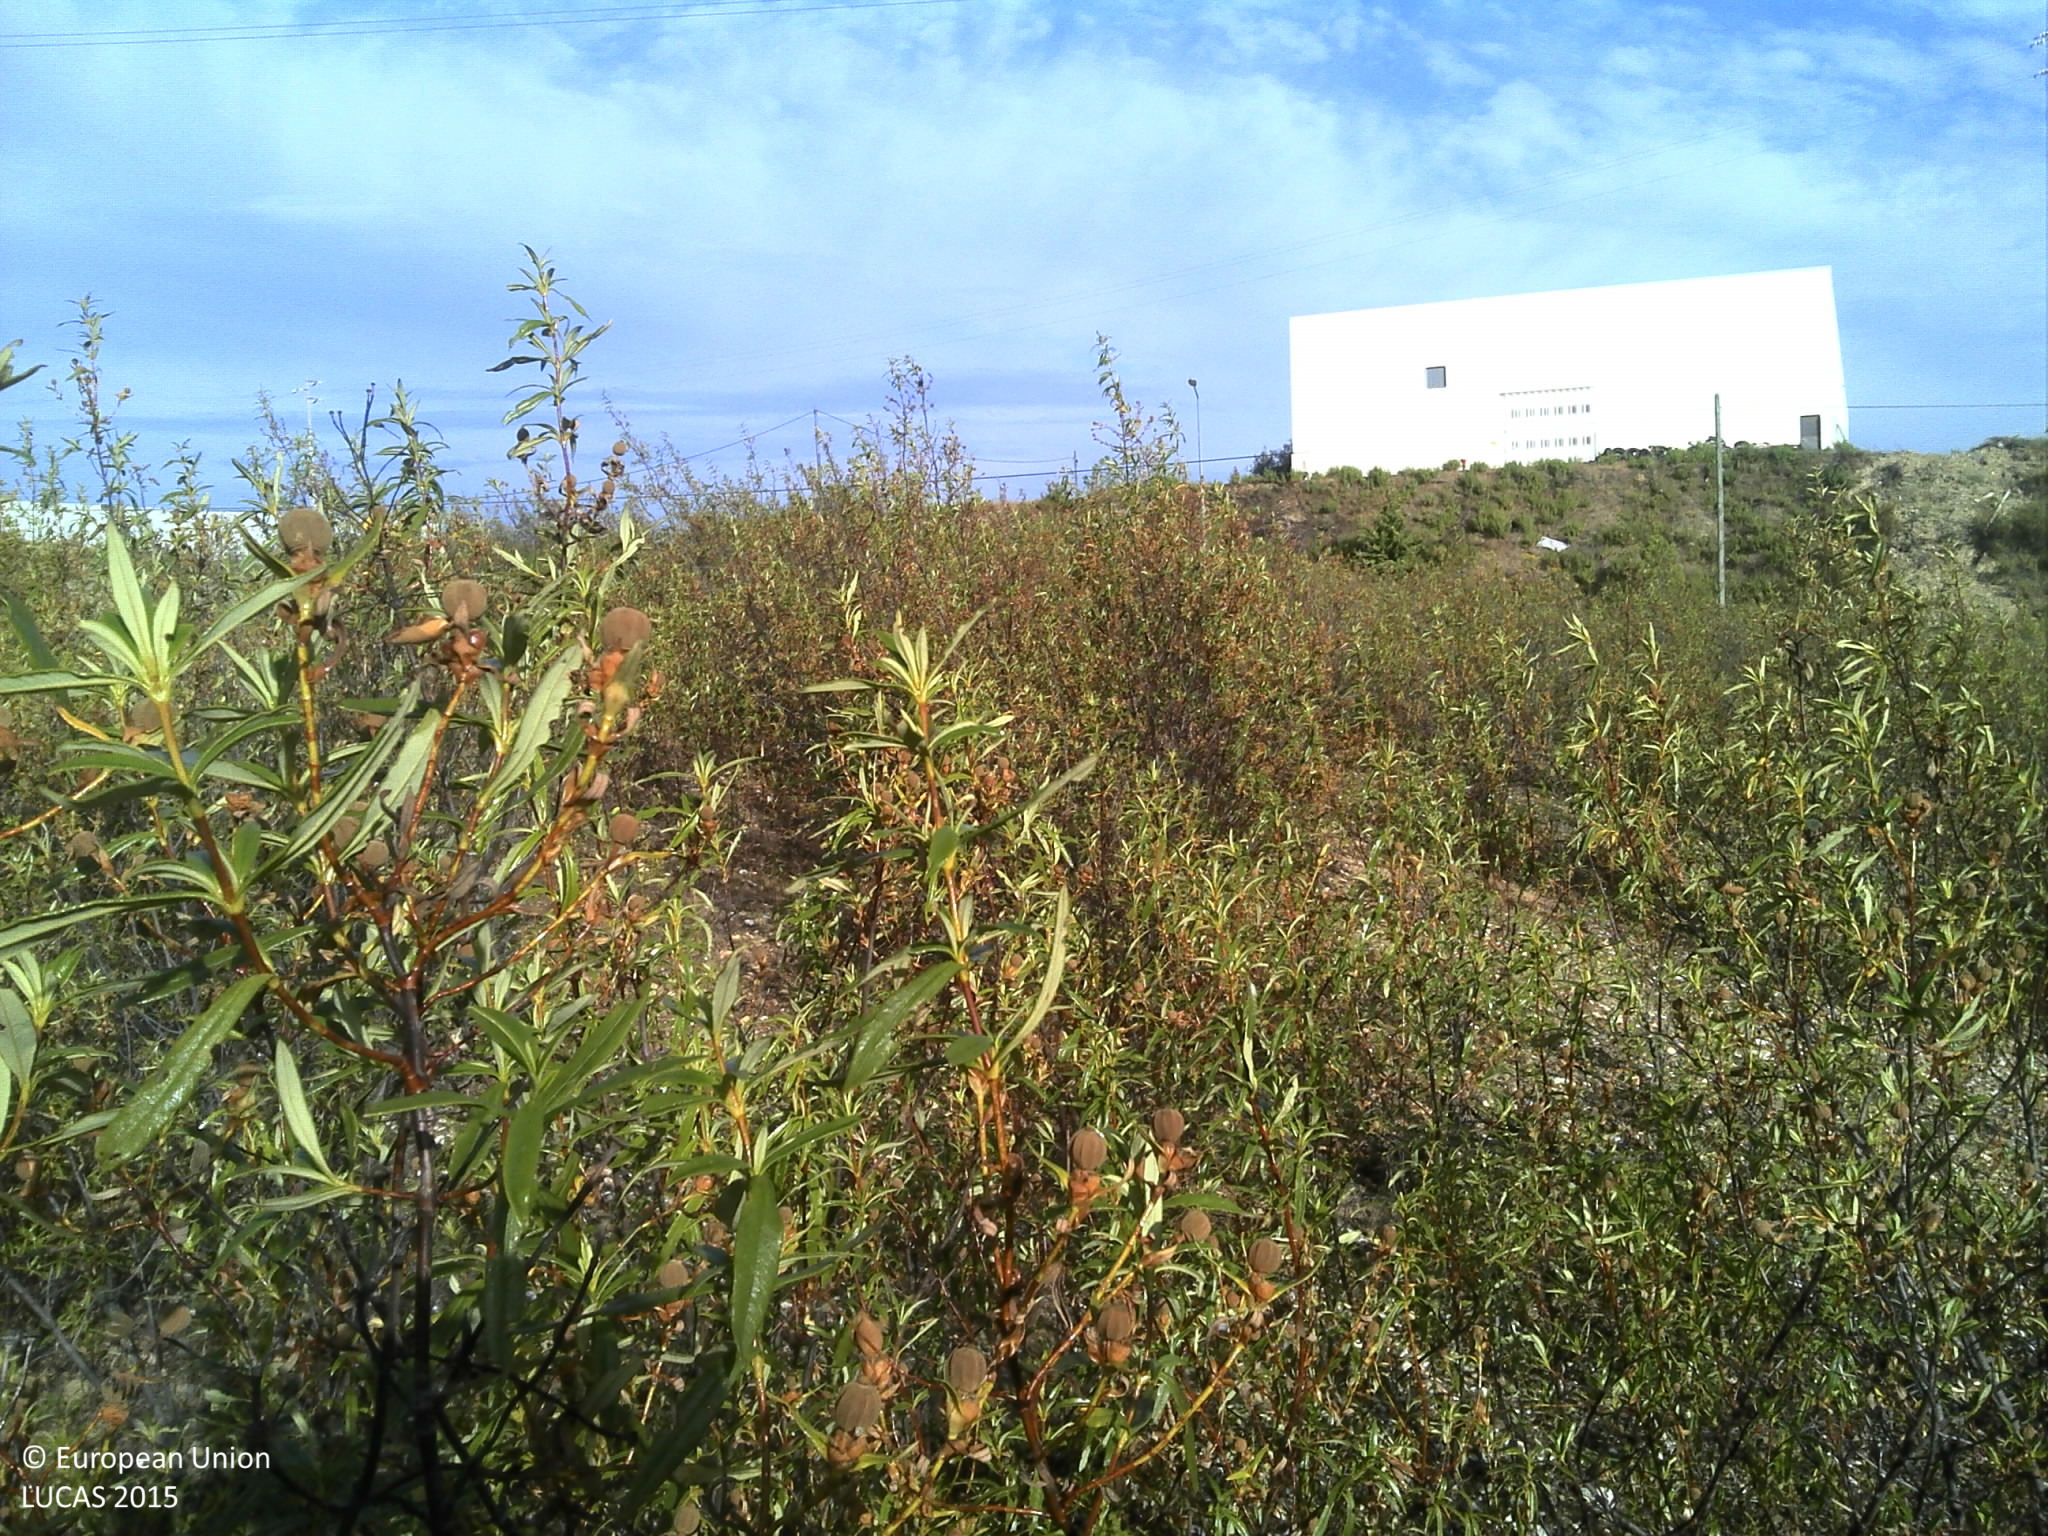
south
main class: Shrubland
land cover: Shrubland without tree cover
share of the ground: 25 - 50 %
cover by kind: shrubs 50 %, unconsolidated bare surface 50 %
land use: Construction
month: July
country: PT
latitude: 39.8000
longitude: -7.5368
